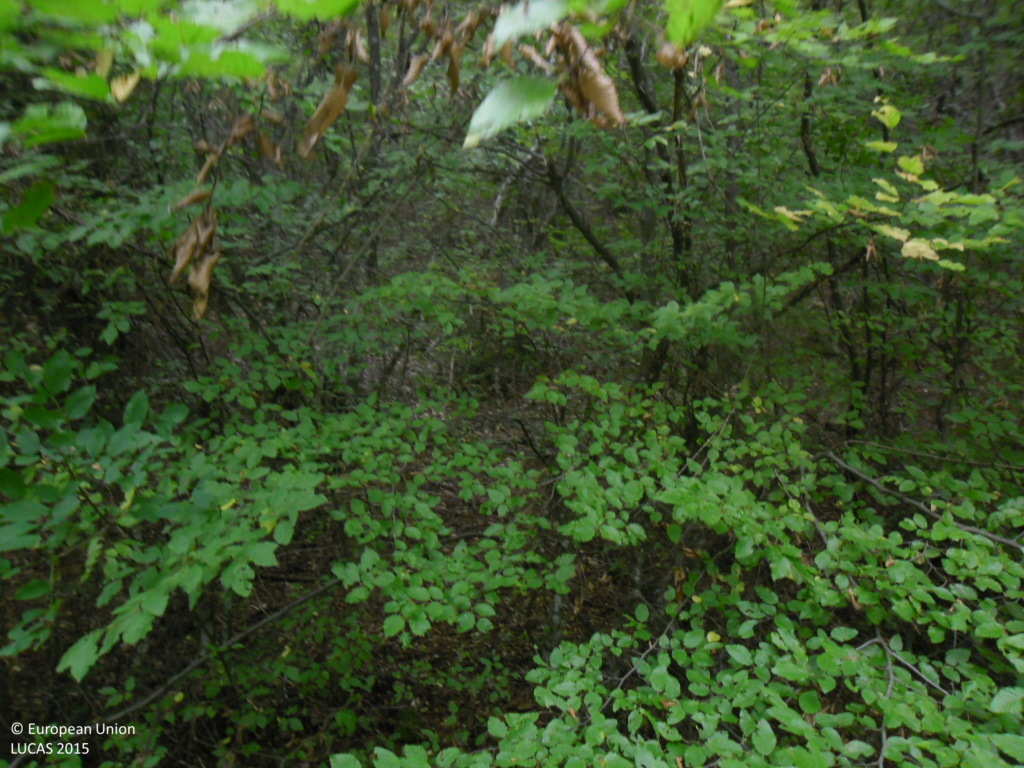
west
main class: Woodland
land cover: Broadleaved woodland
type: mesophytic deciduous forest
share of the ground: > 75 %
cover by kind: broadleaved forest trees 95 %, unconsolidated bare surface 5 %
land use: Forestry
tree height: > 5 m
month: September
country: BG
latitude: 41.9741
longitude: 23.0199
